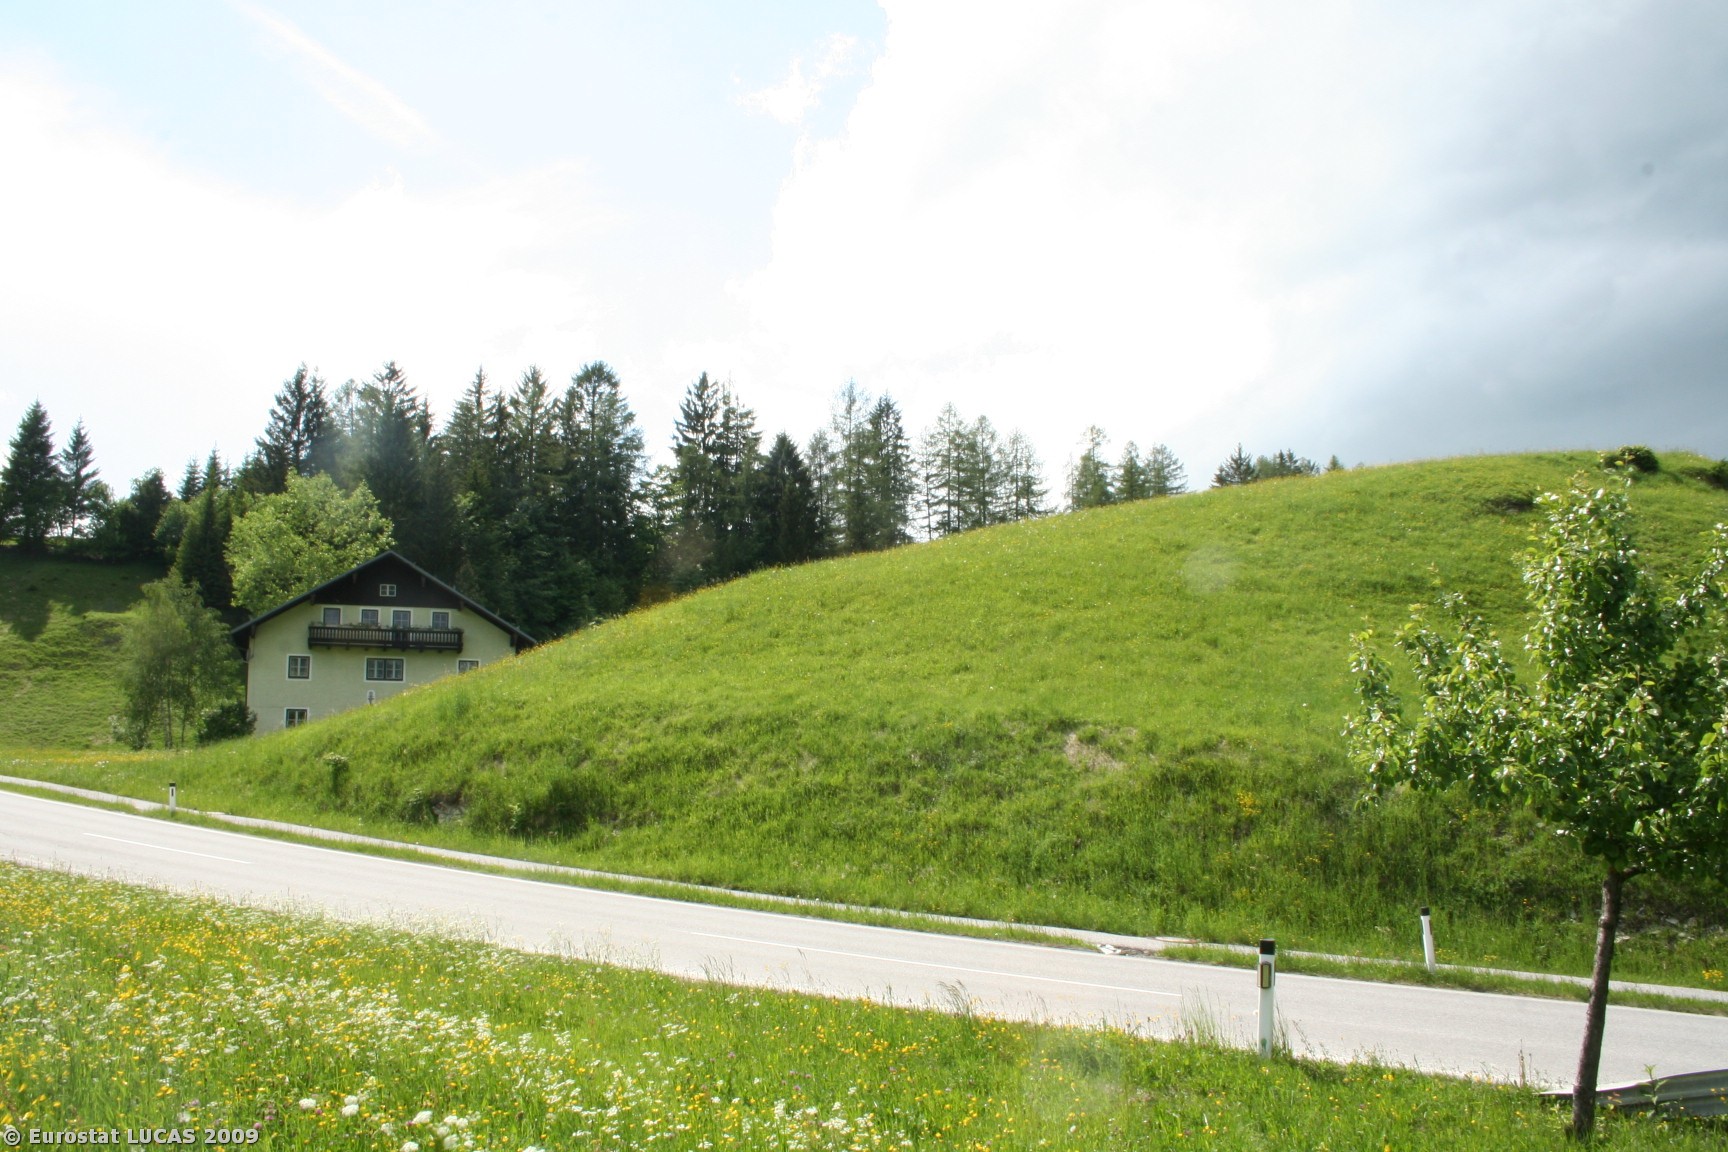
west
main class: Grassland
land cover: Grassland without tree/shrub cover
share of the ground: > 75 %
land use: Agriculture (excluding fallow land and kitchen gardens)
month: May
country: AT
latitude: 47.6366
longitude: 13.2061
